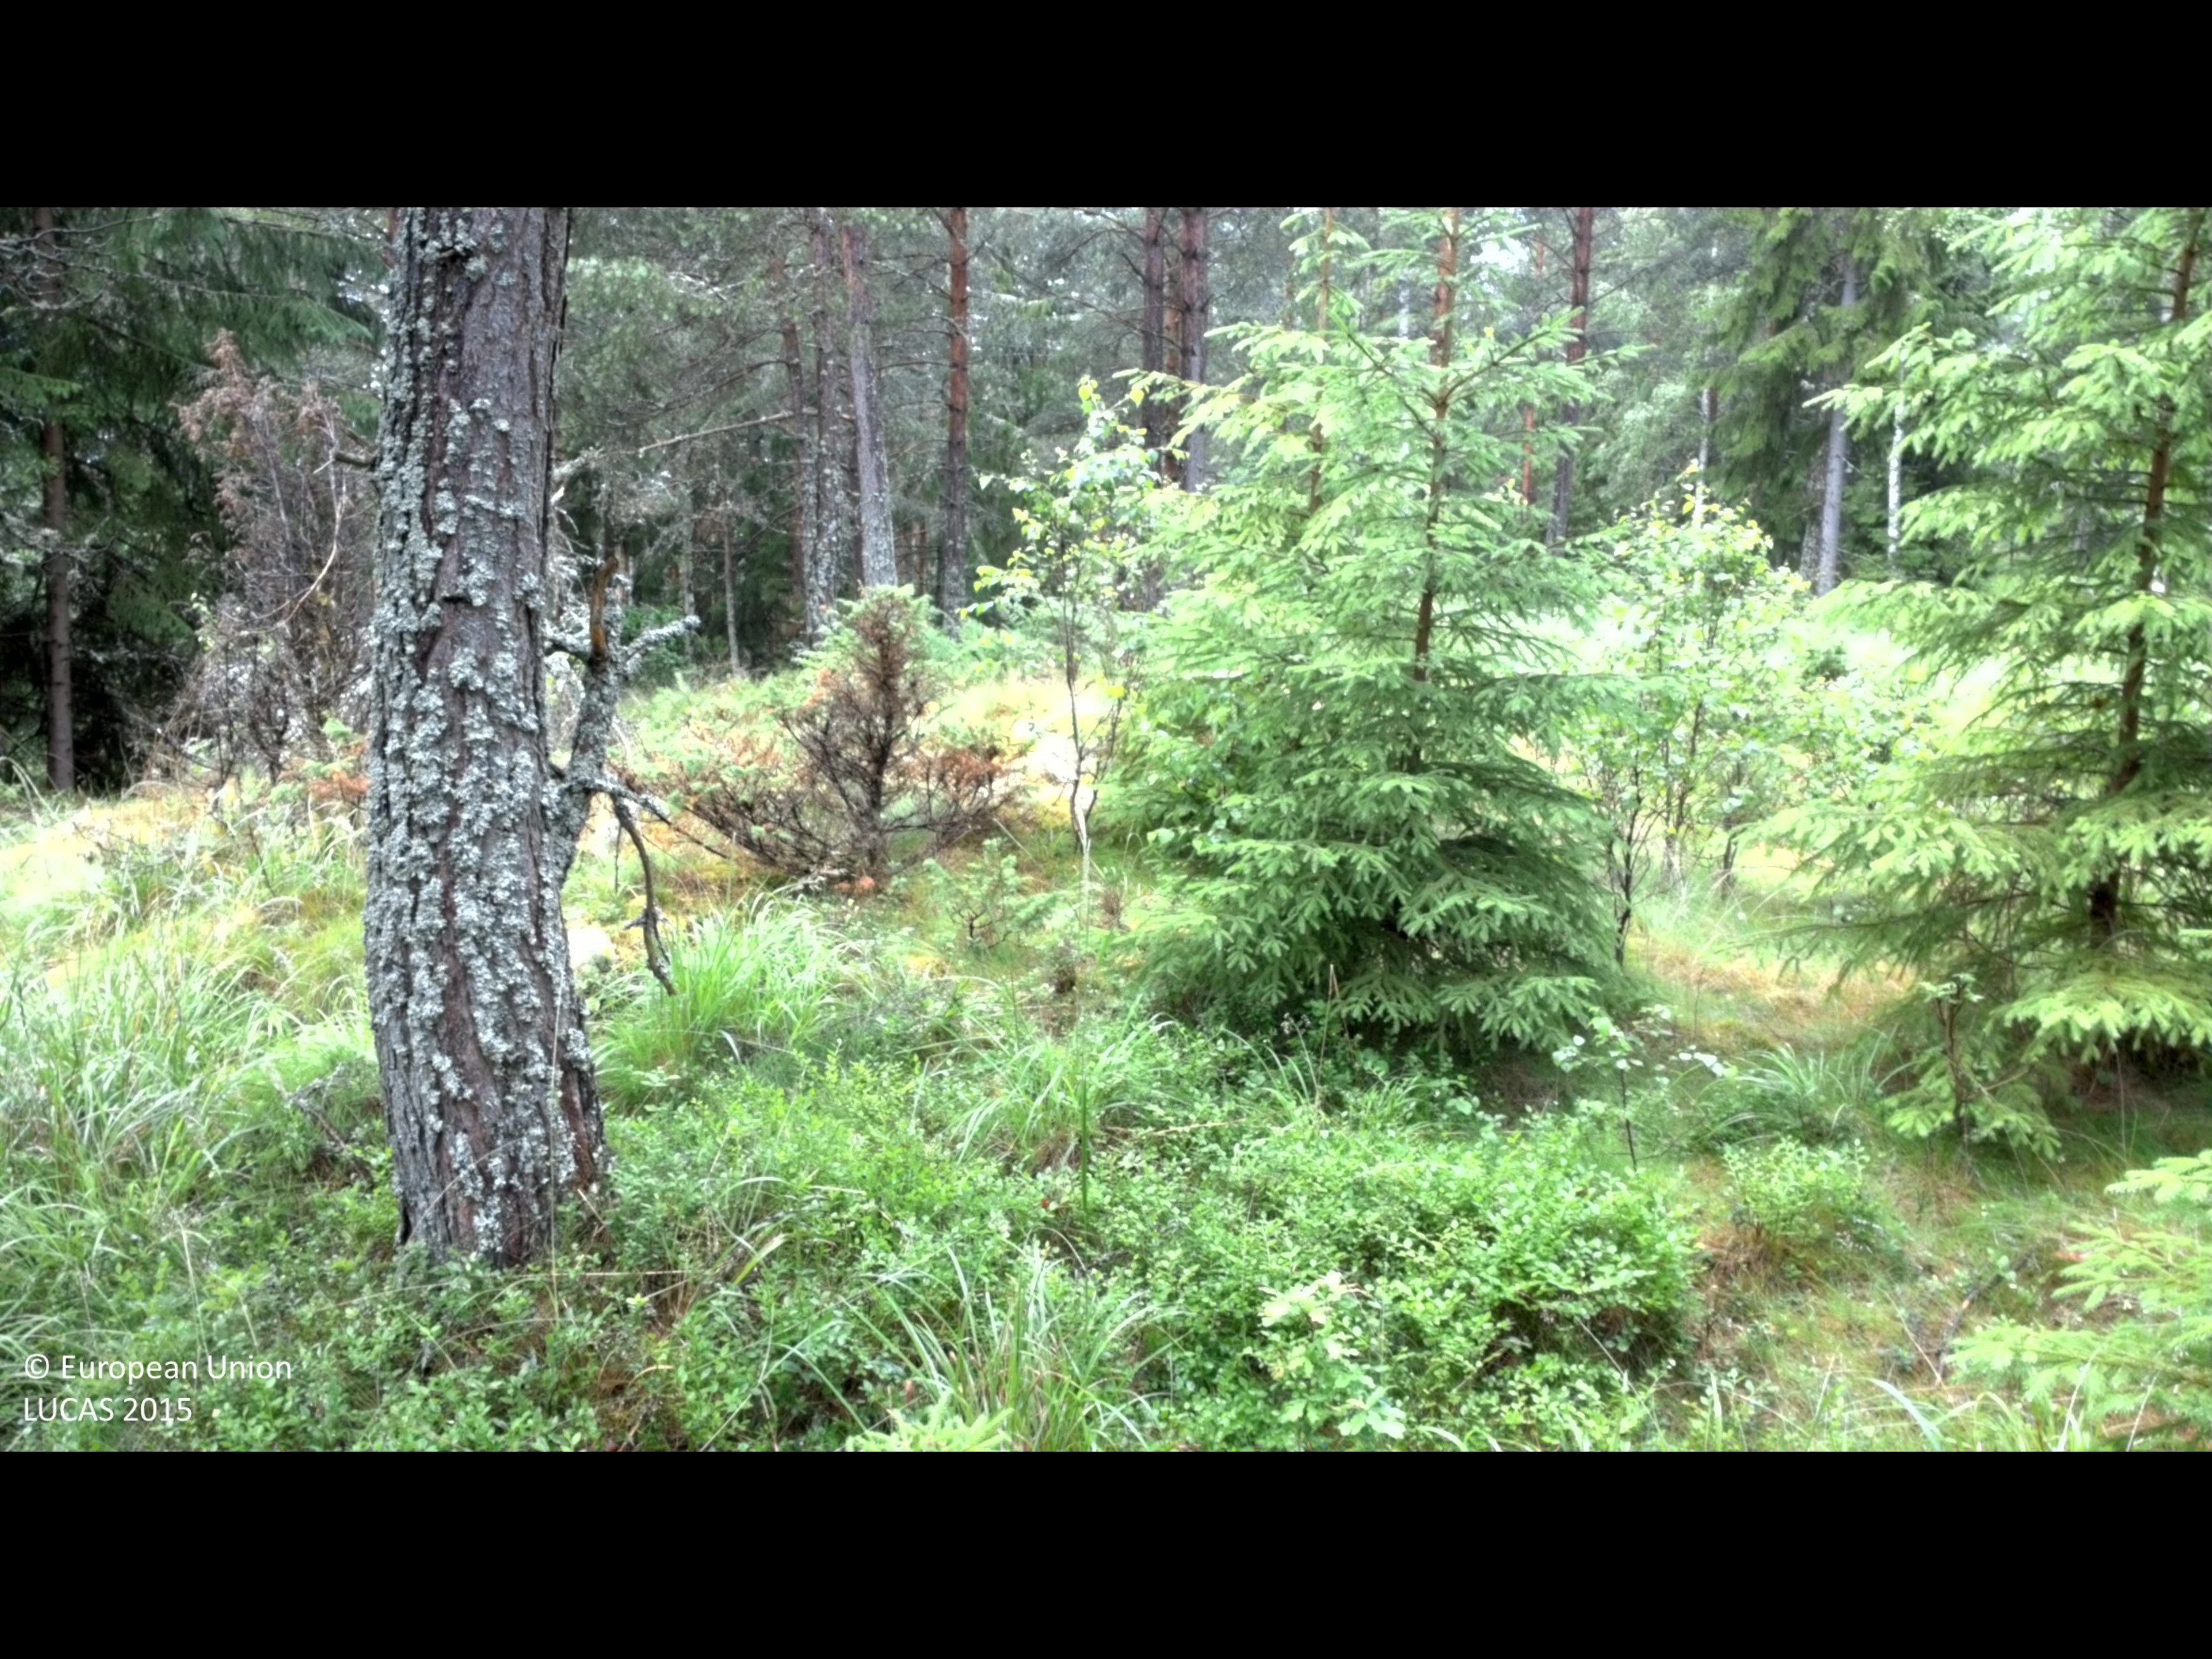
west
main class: Woodland
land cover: Pine dominated coniferous woodland
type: boreal forest
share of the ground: 50 - 75 %
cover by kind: coniferous forest trees 55 %, shrubs 30 %, lichens and mosses 10 %, herbaceous plants 5 %
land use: Forestry
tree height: > 5 m
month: July
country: SE
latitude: 58.3652
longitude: 16.2008
